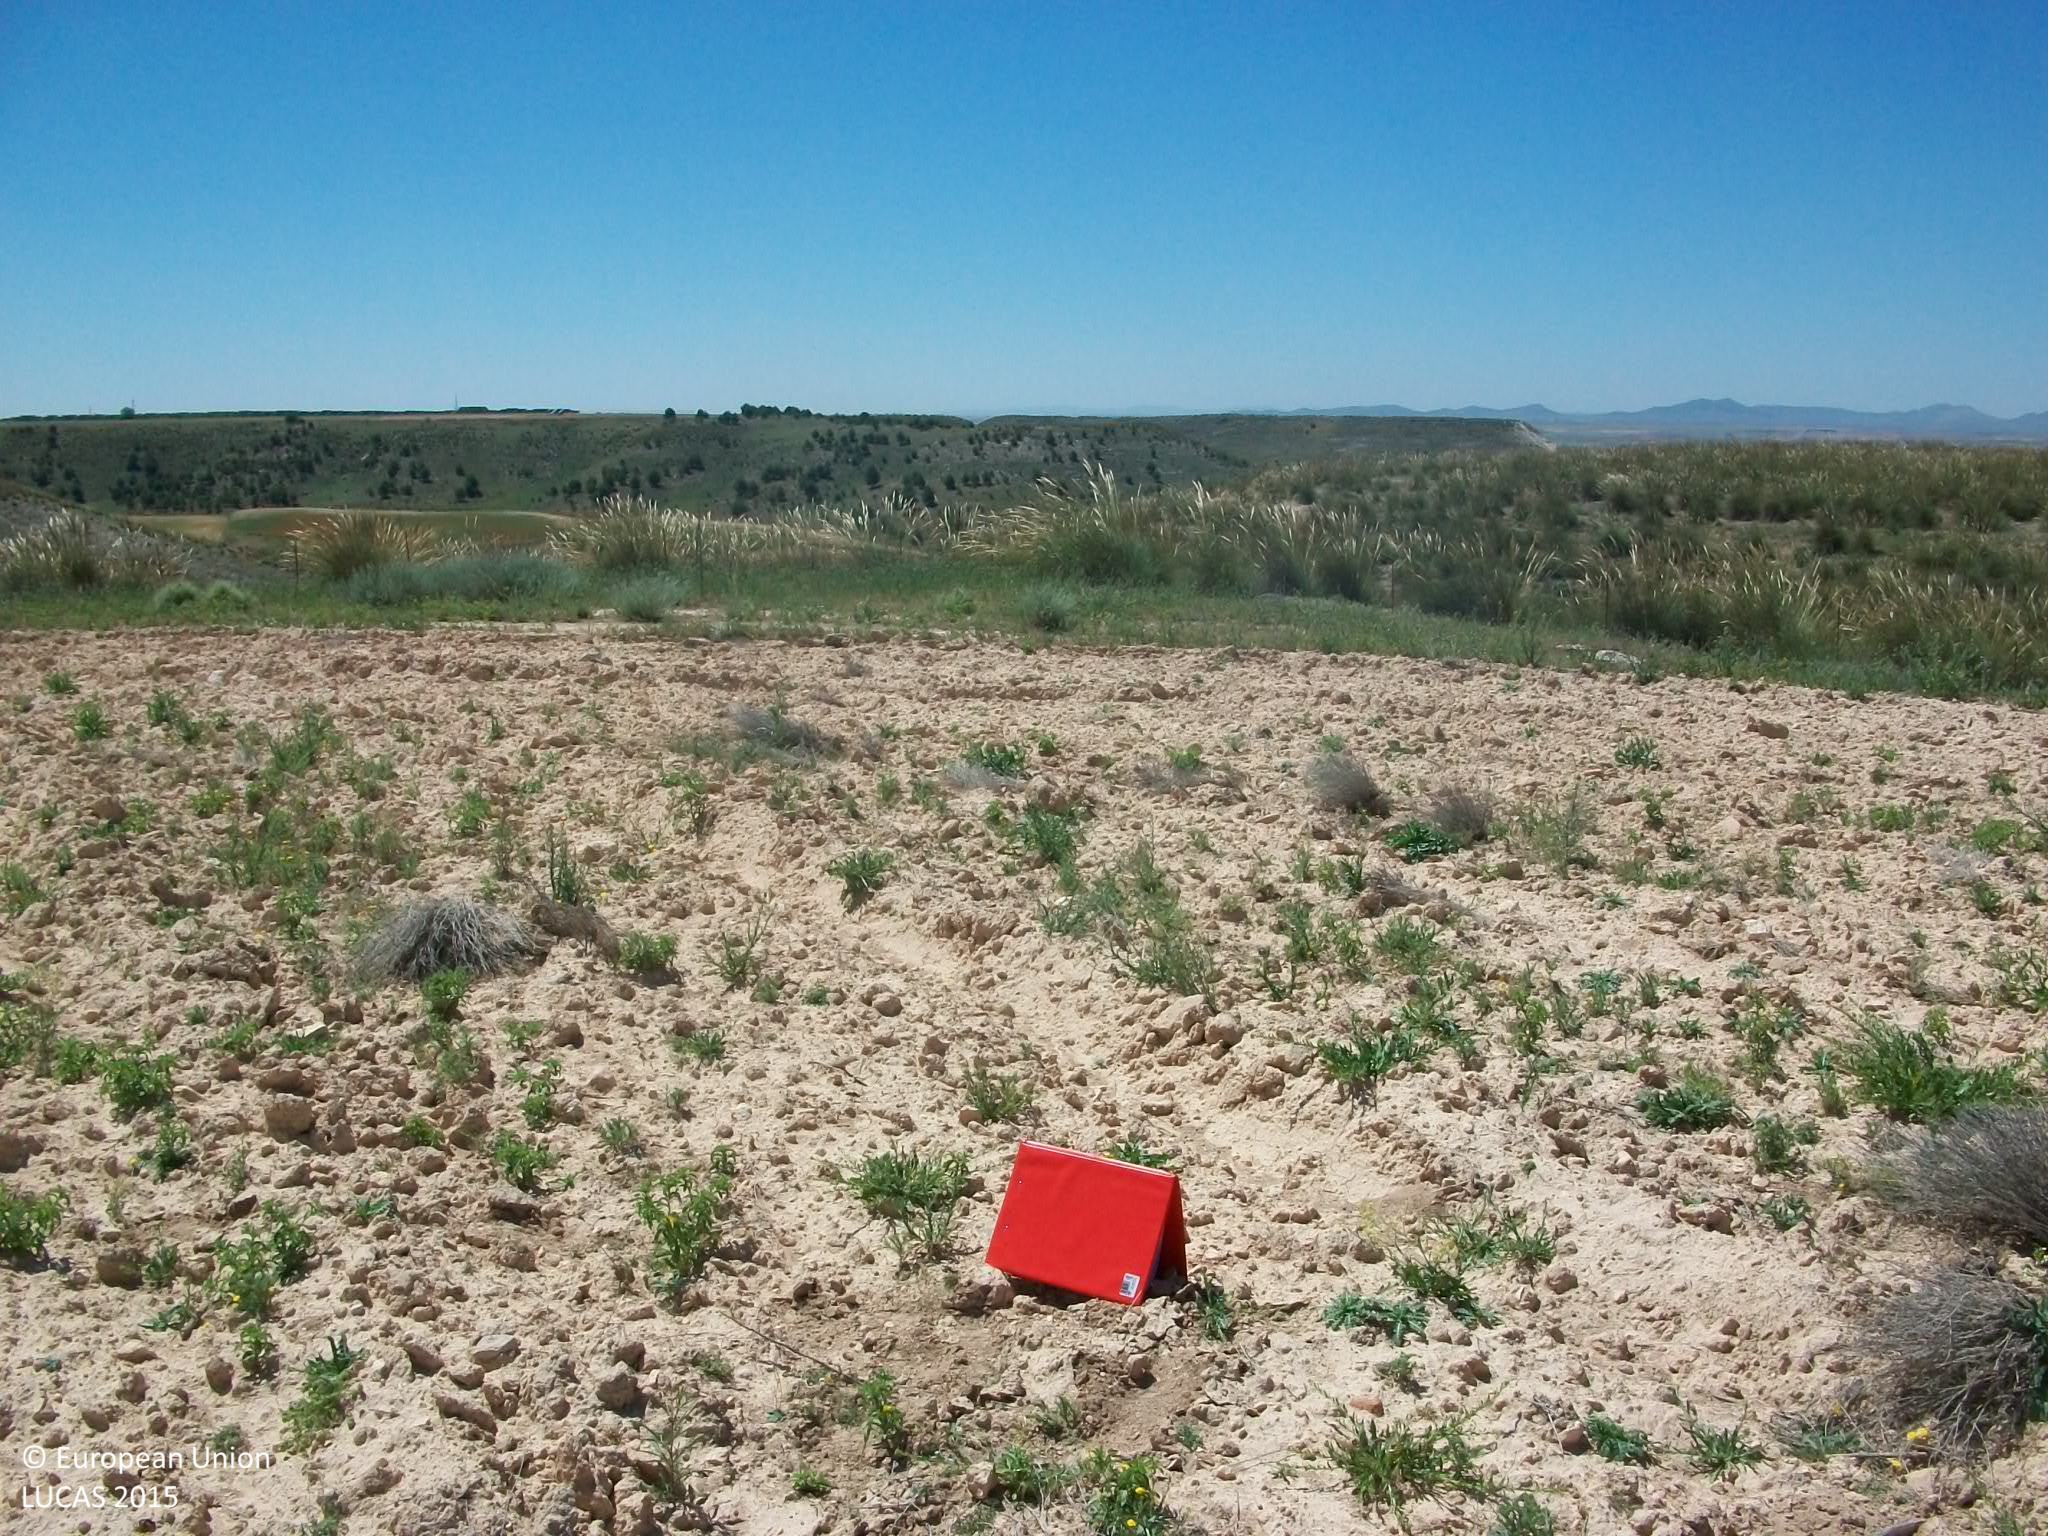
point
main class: Grassland
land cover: Spontaneously vegetated surfaces
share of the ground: 25 - 50 %
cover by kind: unconsolidated bare surface 70 %, herbaceous plants 30 %
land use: Fallow land
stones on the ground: 10 - 25 %
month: May
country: ES
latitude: 39.8794
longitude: -3.6281
